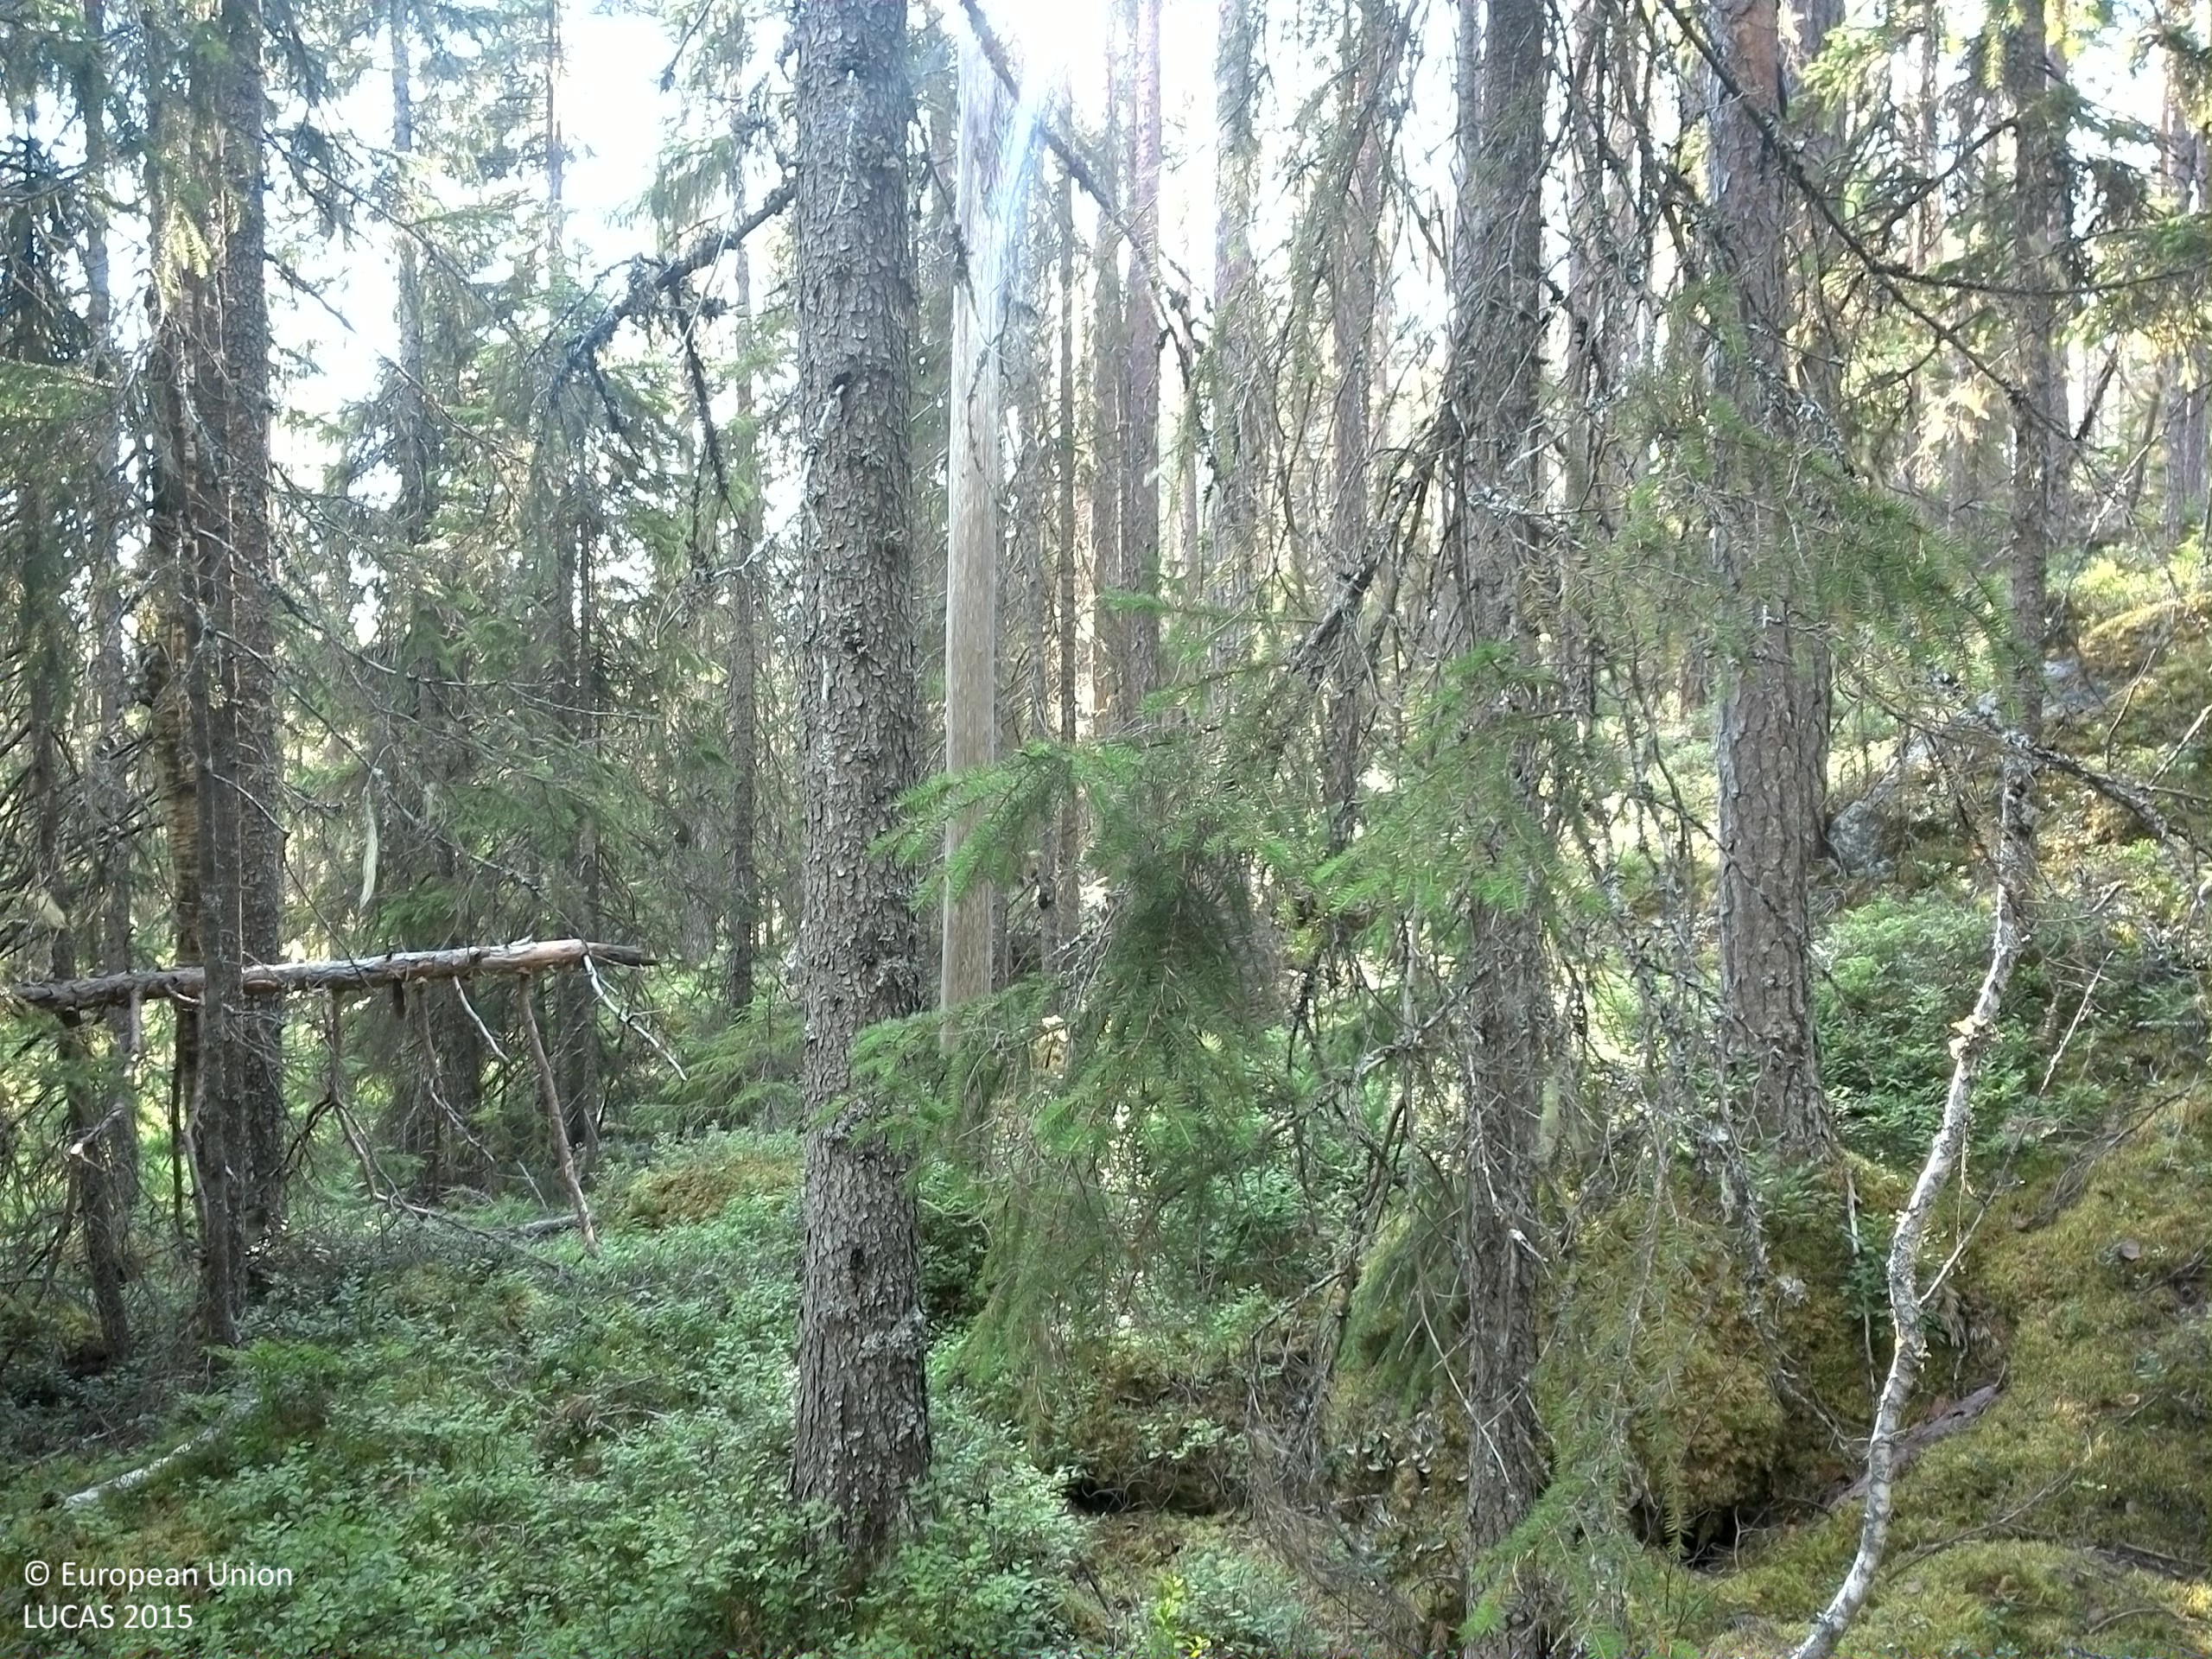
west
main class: Woodland
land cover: Pine dominated coniferous woodland
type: boreal forest
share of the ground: 50 - 75 %
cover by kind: coniferous forest trees 50 %, shrubs 35 %, lichens and mosses 15 %
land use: Forestry
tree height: > 5 m
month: August
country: SE
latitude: 63.6361
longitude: 16.3714
